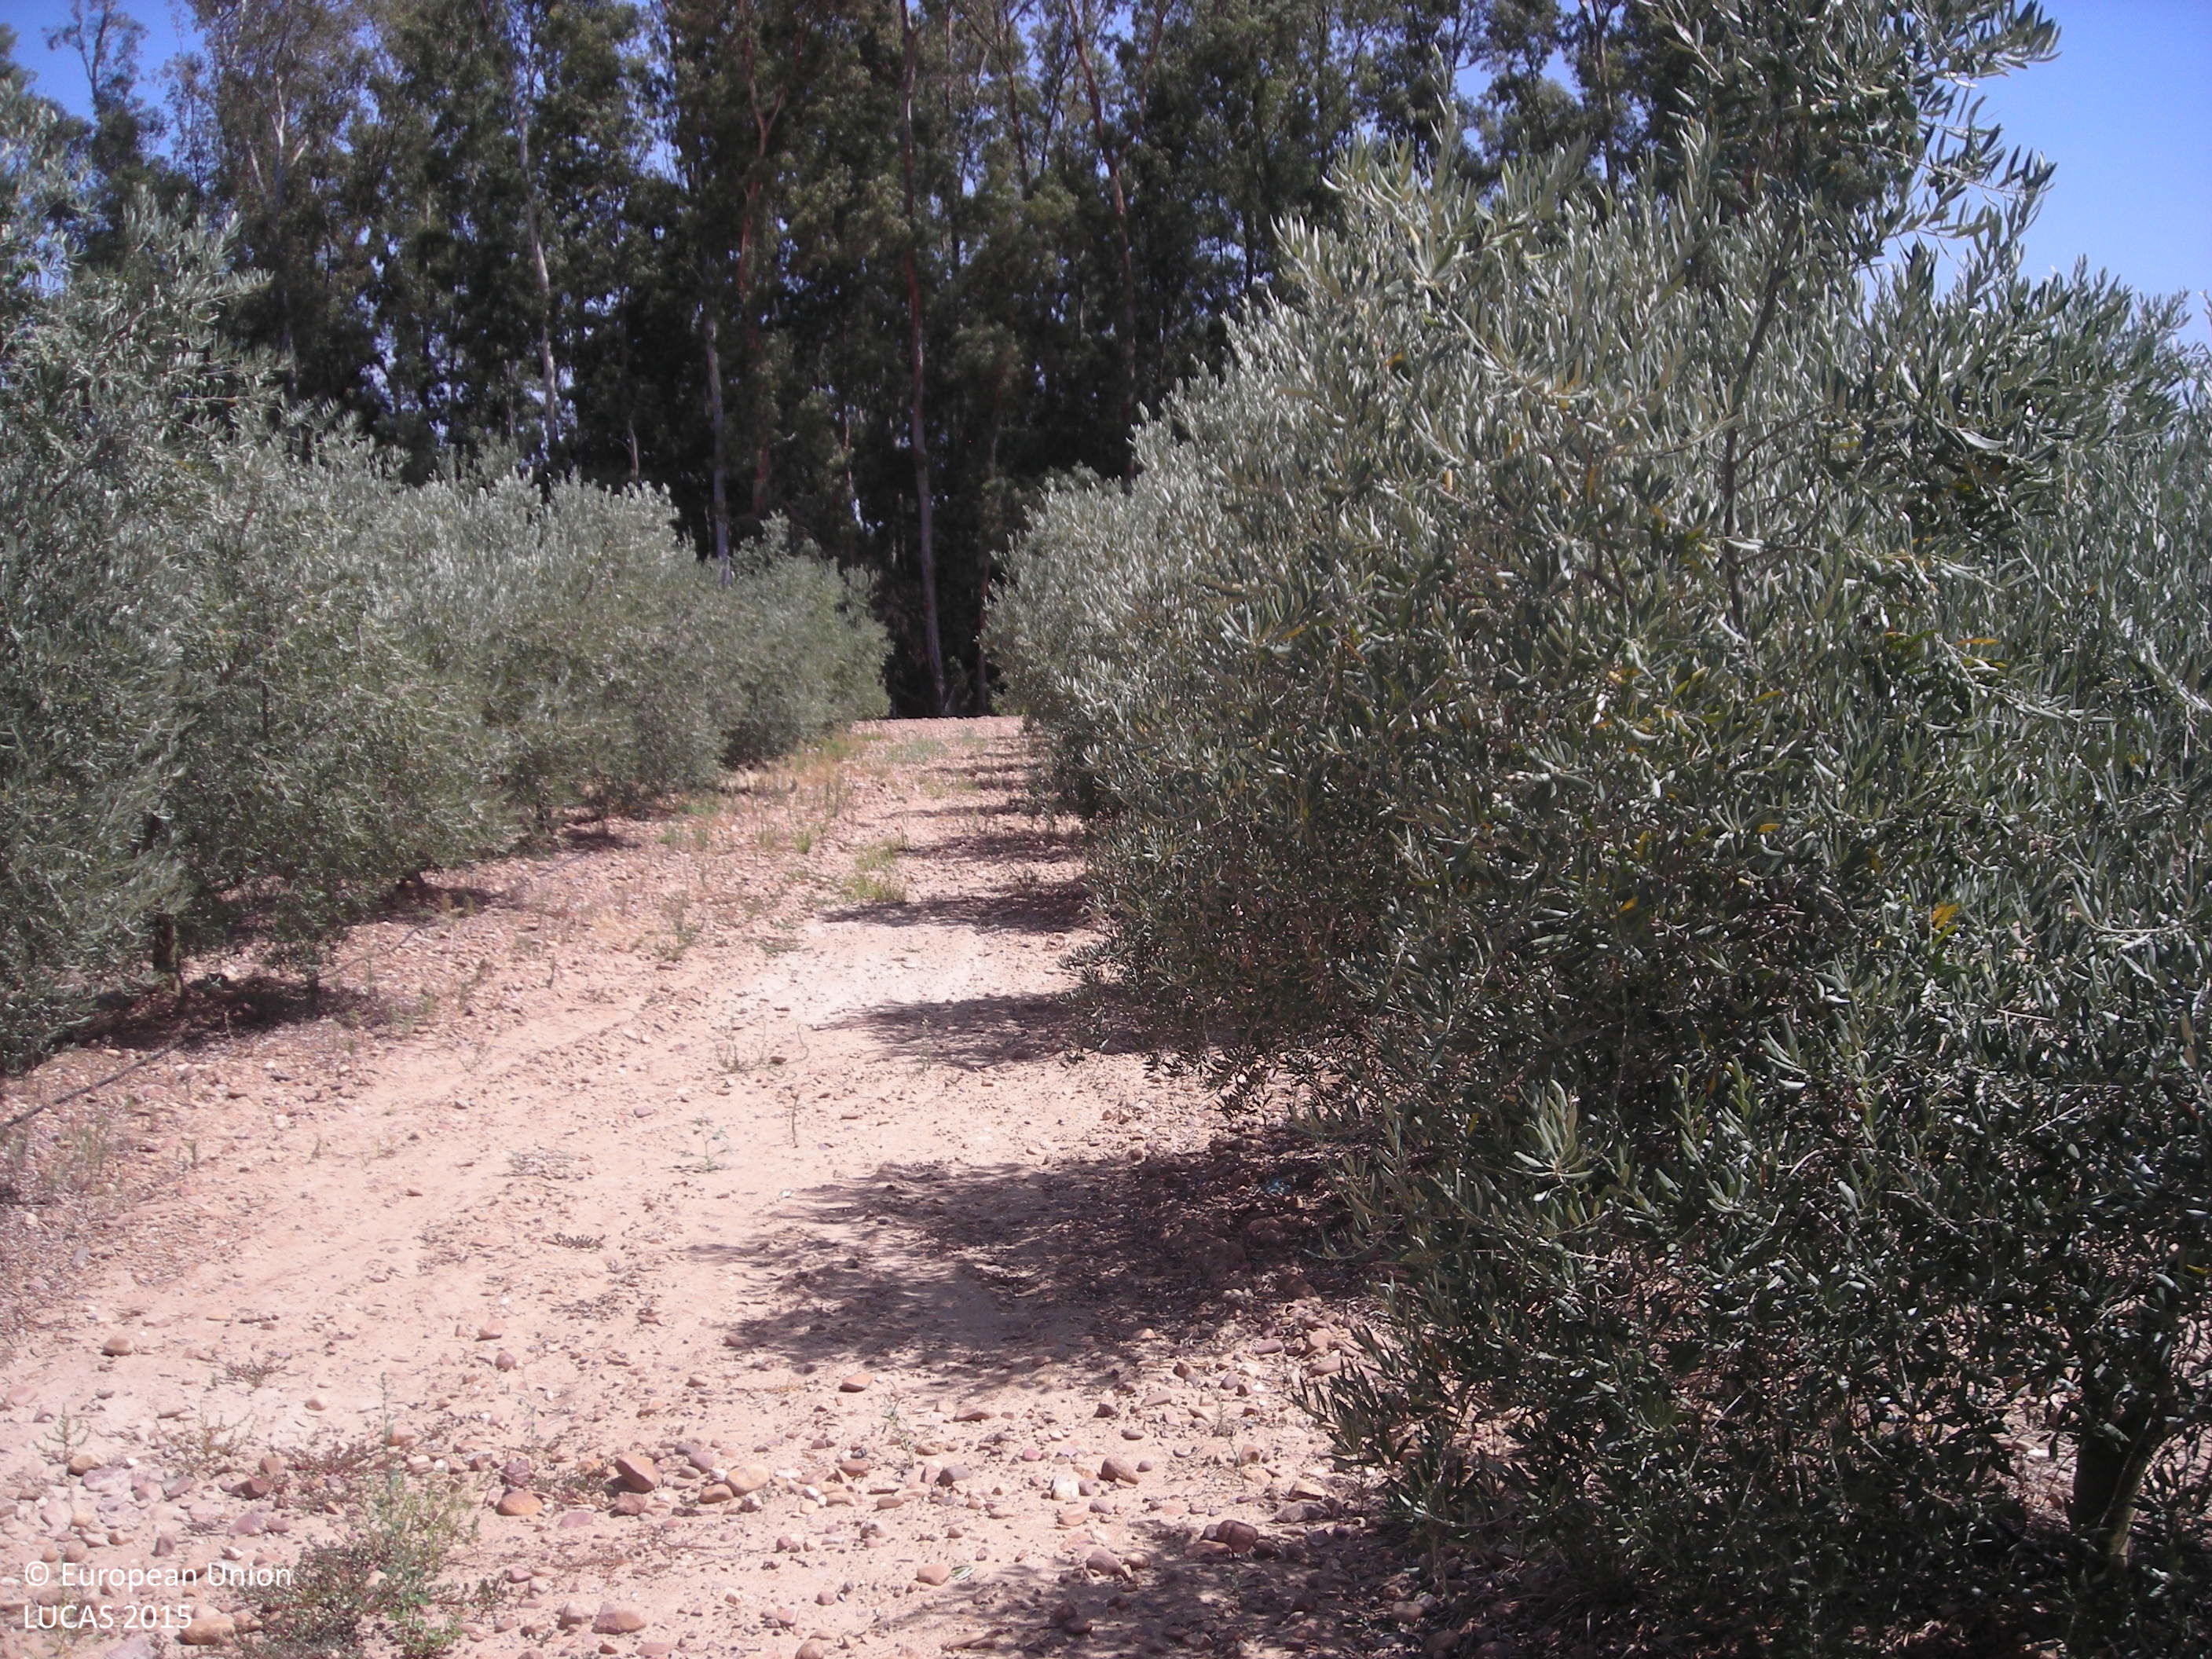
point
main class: Cropland
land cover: Olive groves
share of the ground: 25 - 50 %
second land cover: Other bare soil
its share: > 75 %
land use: Agriculture (excluding fallow land and kitchen gardens)
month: July
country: ES
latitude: 38.9685
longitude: -5.9673
